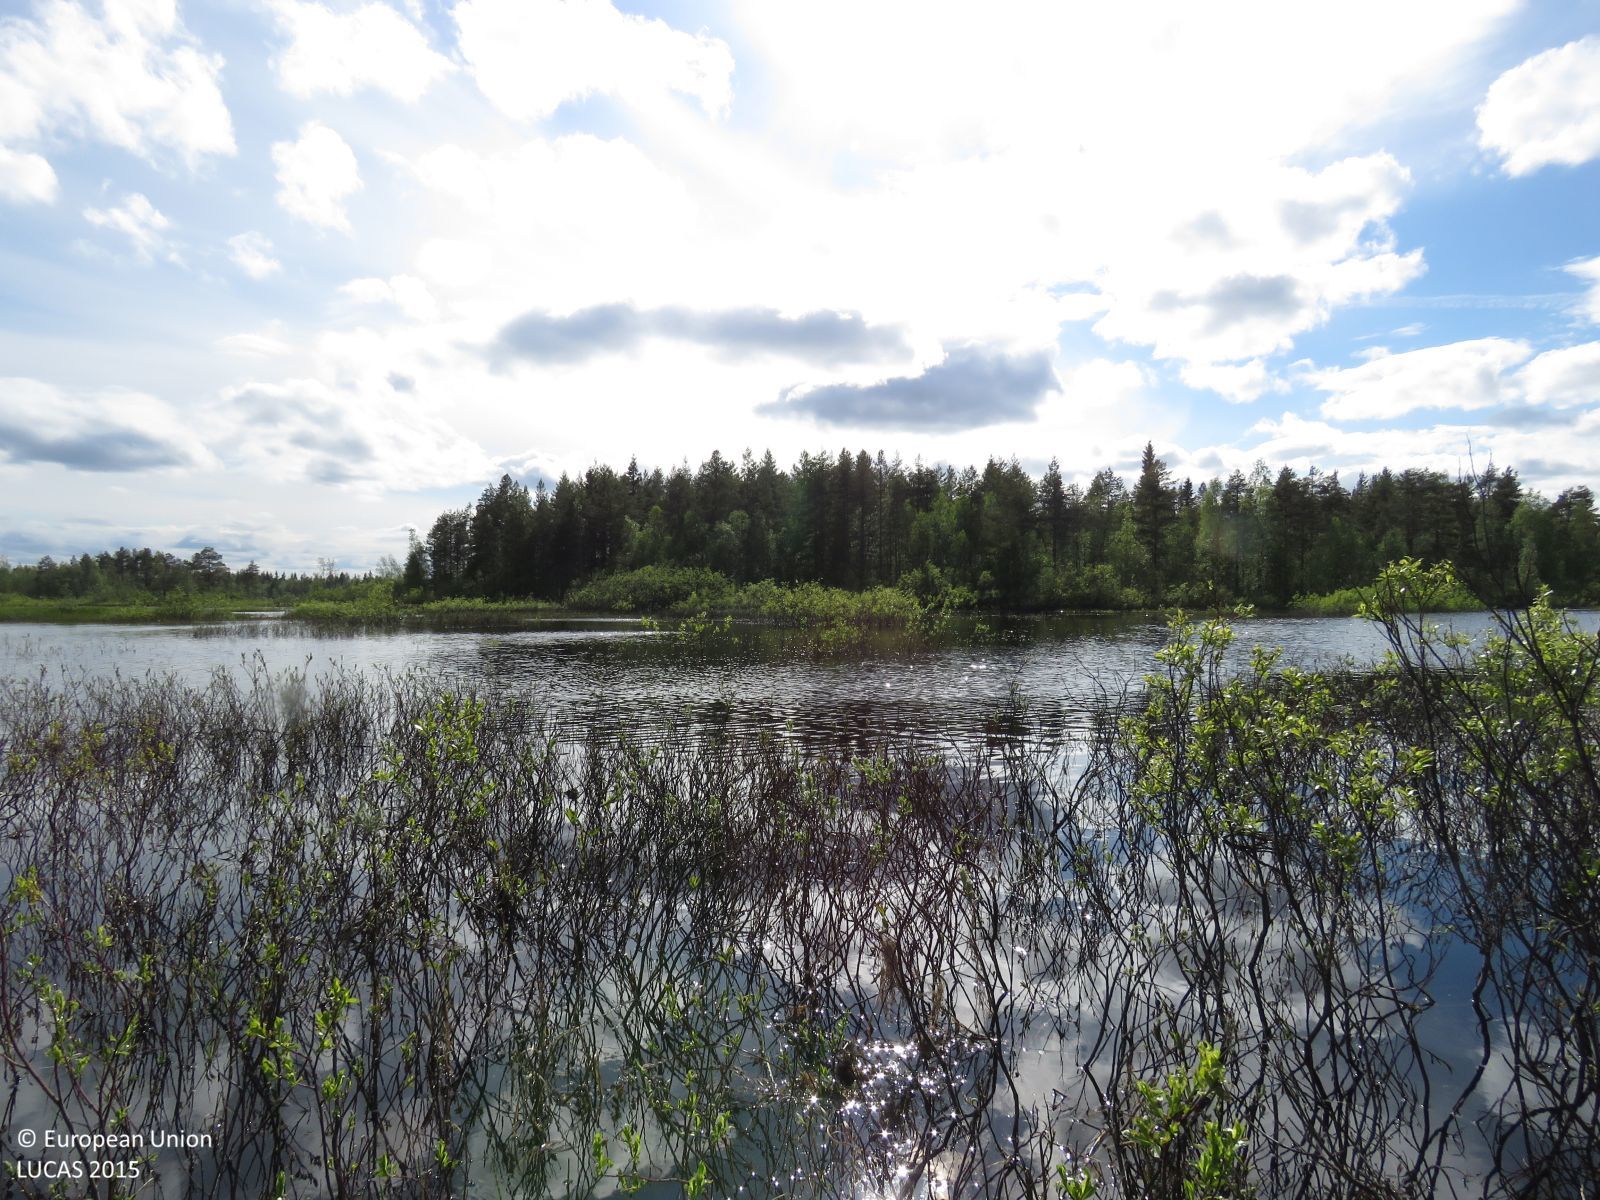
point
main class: Woodland
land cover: Pine dominated mixed woodland
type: boreal forest
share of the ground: 50 - 75 %
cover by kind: coniferous forest trees 40 %, broadleaved forest trees 15 %
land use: Forestry
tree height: > 5 m
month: June
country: FI
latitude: 65.3144
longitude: 26.9617
